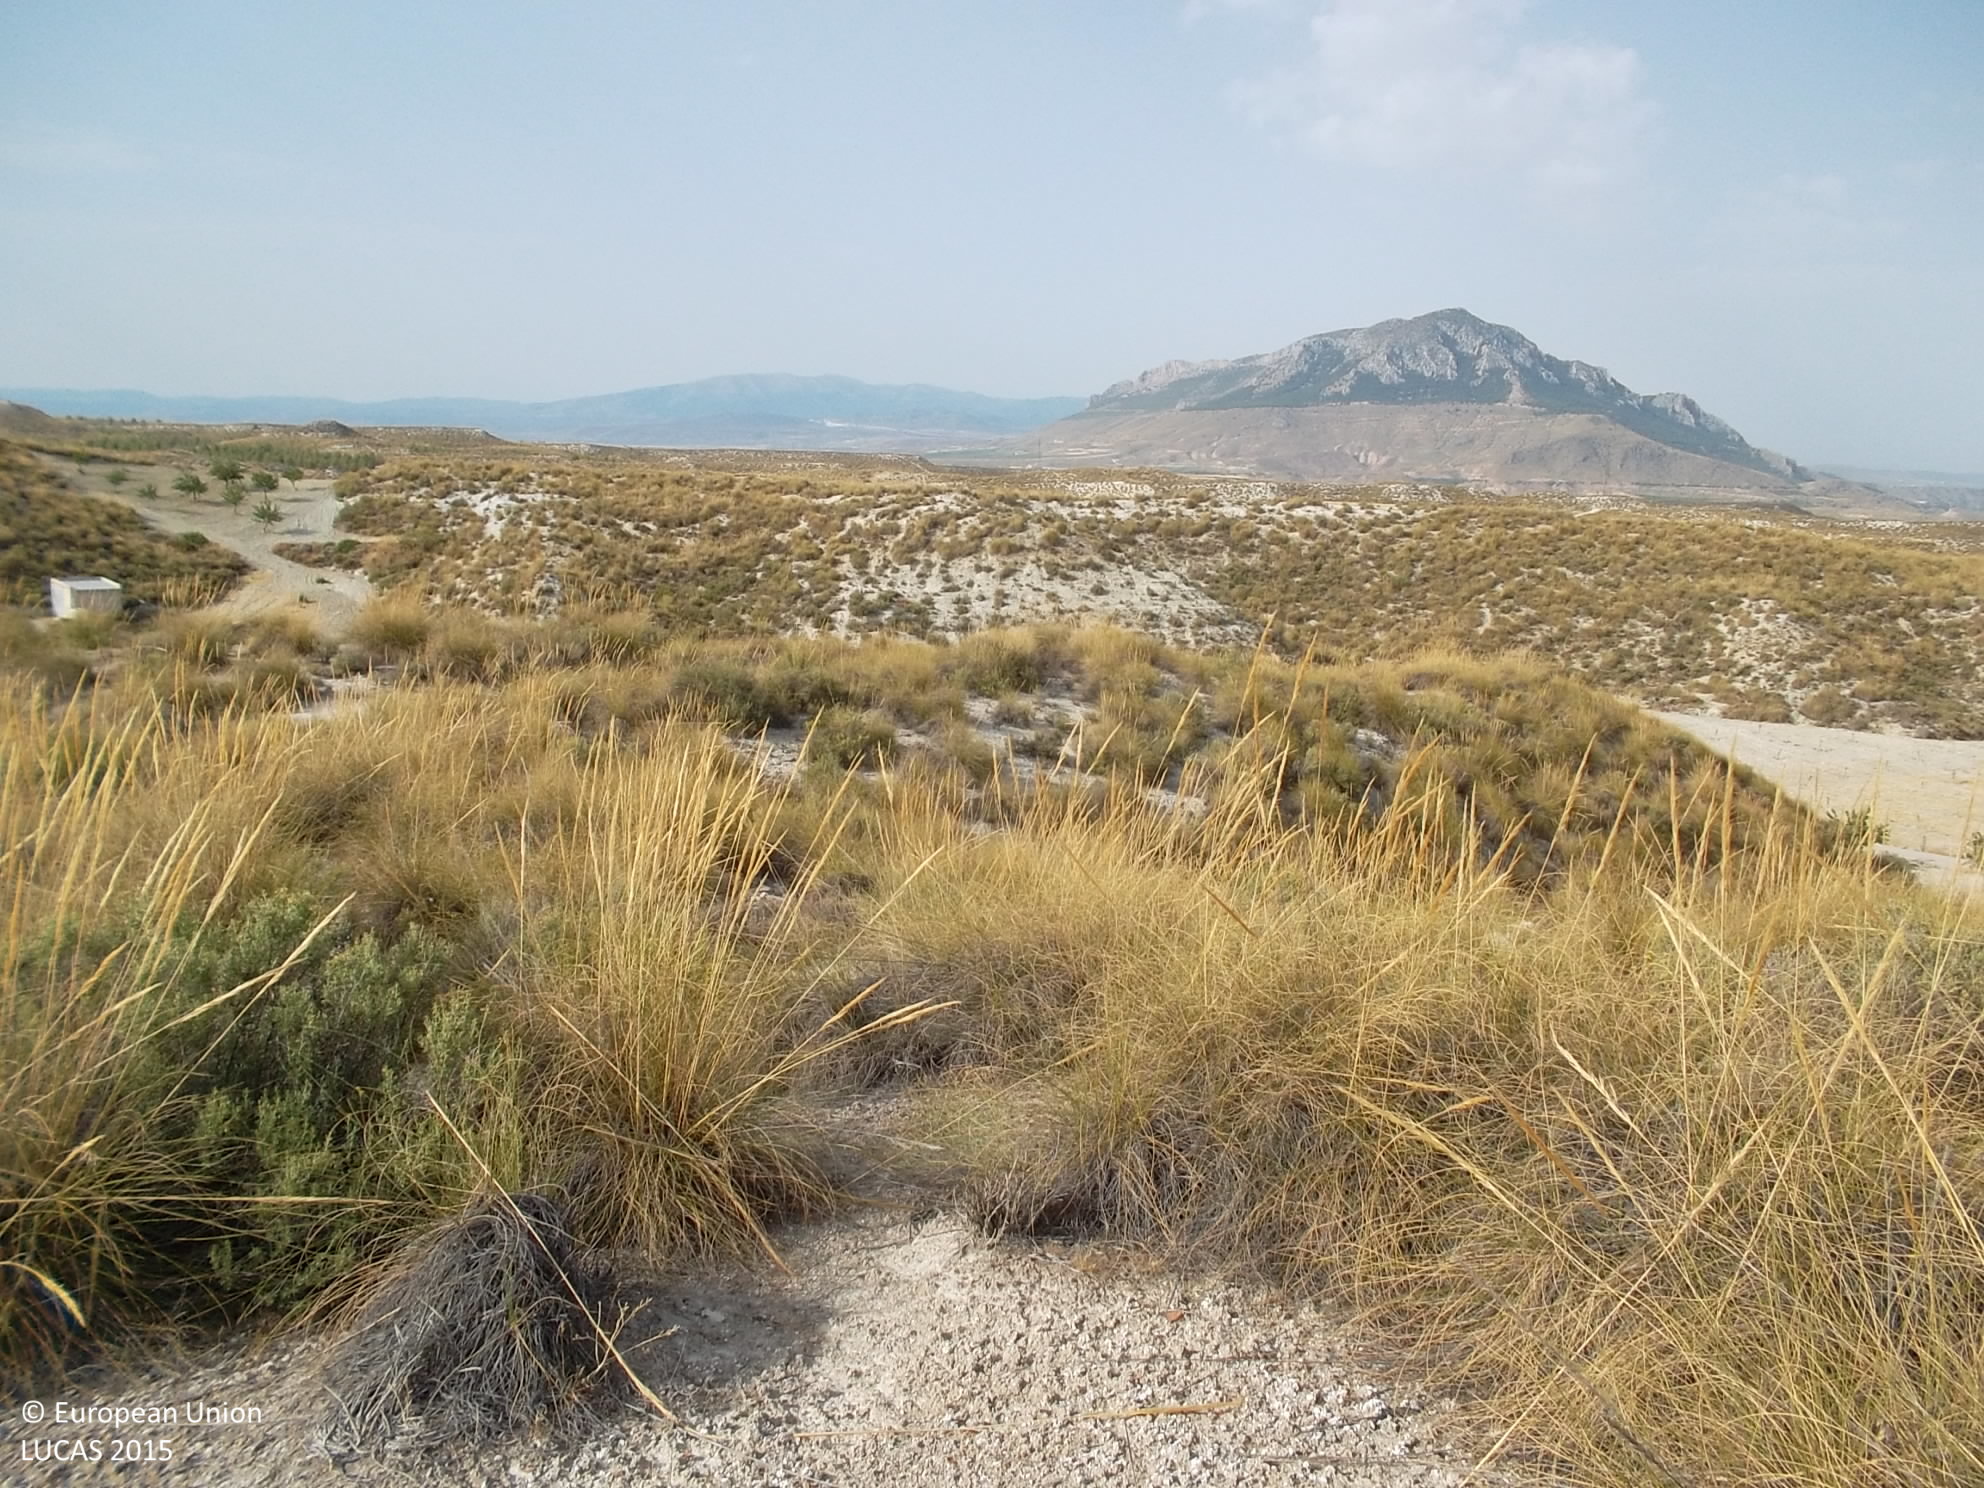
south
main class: Shrubland
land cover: Shrubland without tree cover
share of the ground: 50 - 75 %
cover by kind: shrubs 60 %, herbaceous plants 20 %, consolidated bare surface 20 %
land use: Semi-natural and natural areas not in use
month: July
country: ES
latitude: 37.6358
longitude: -2.7604
